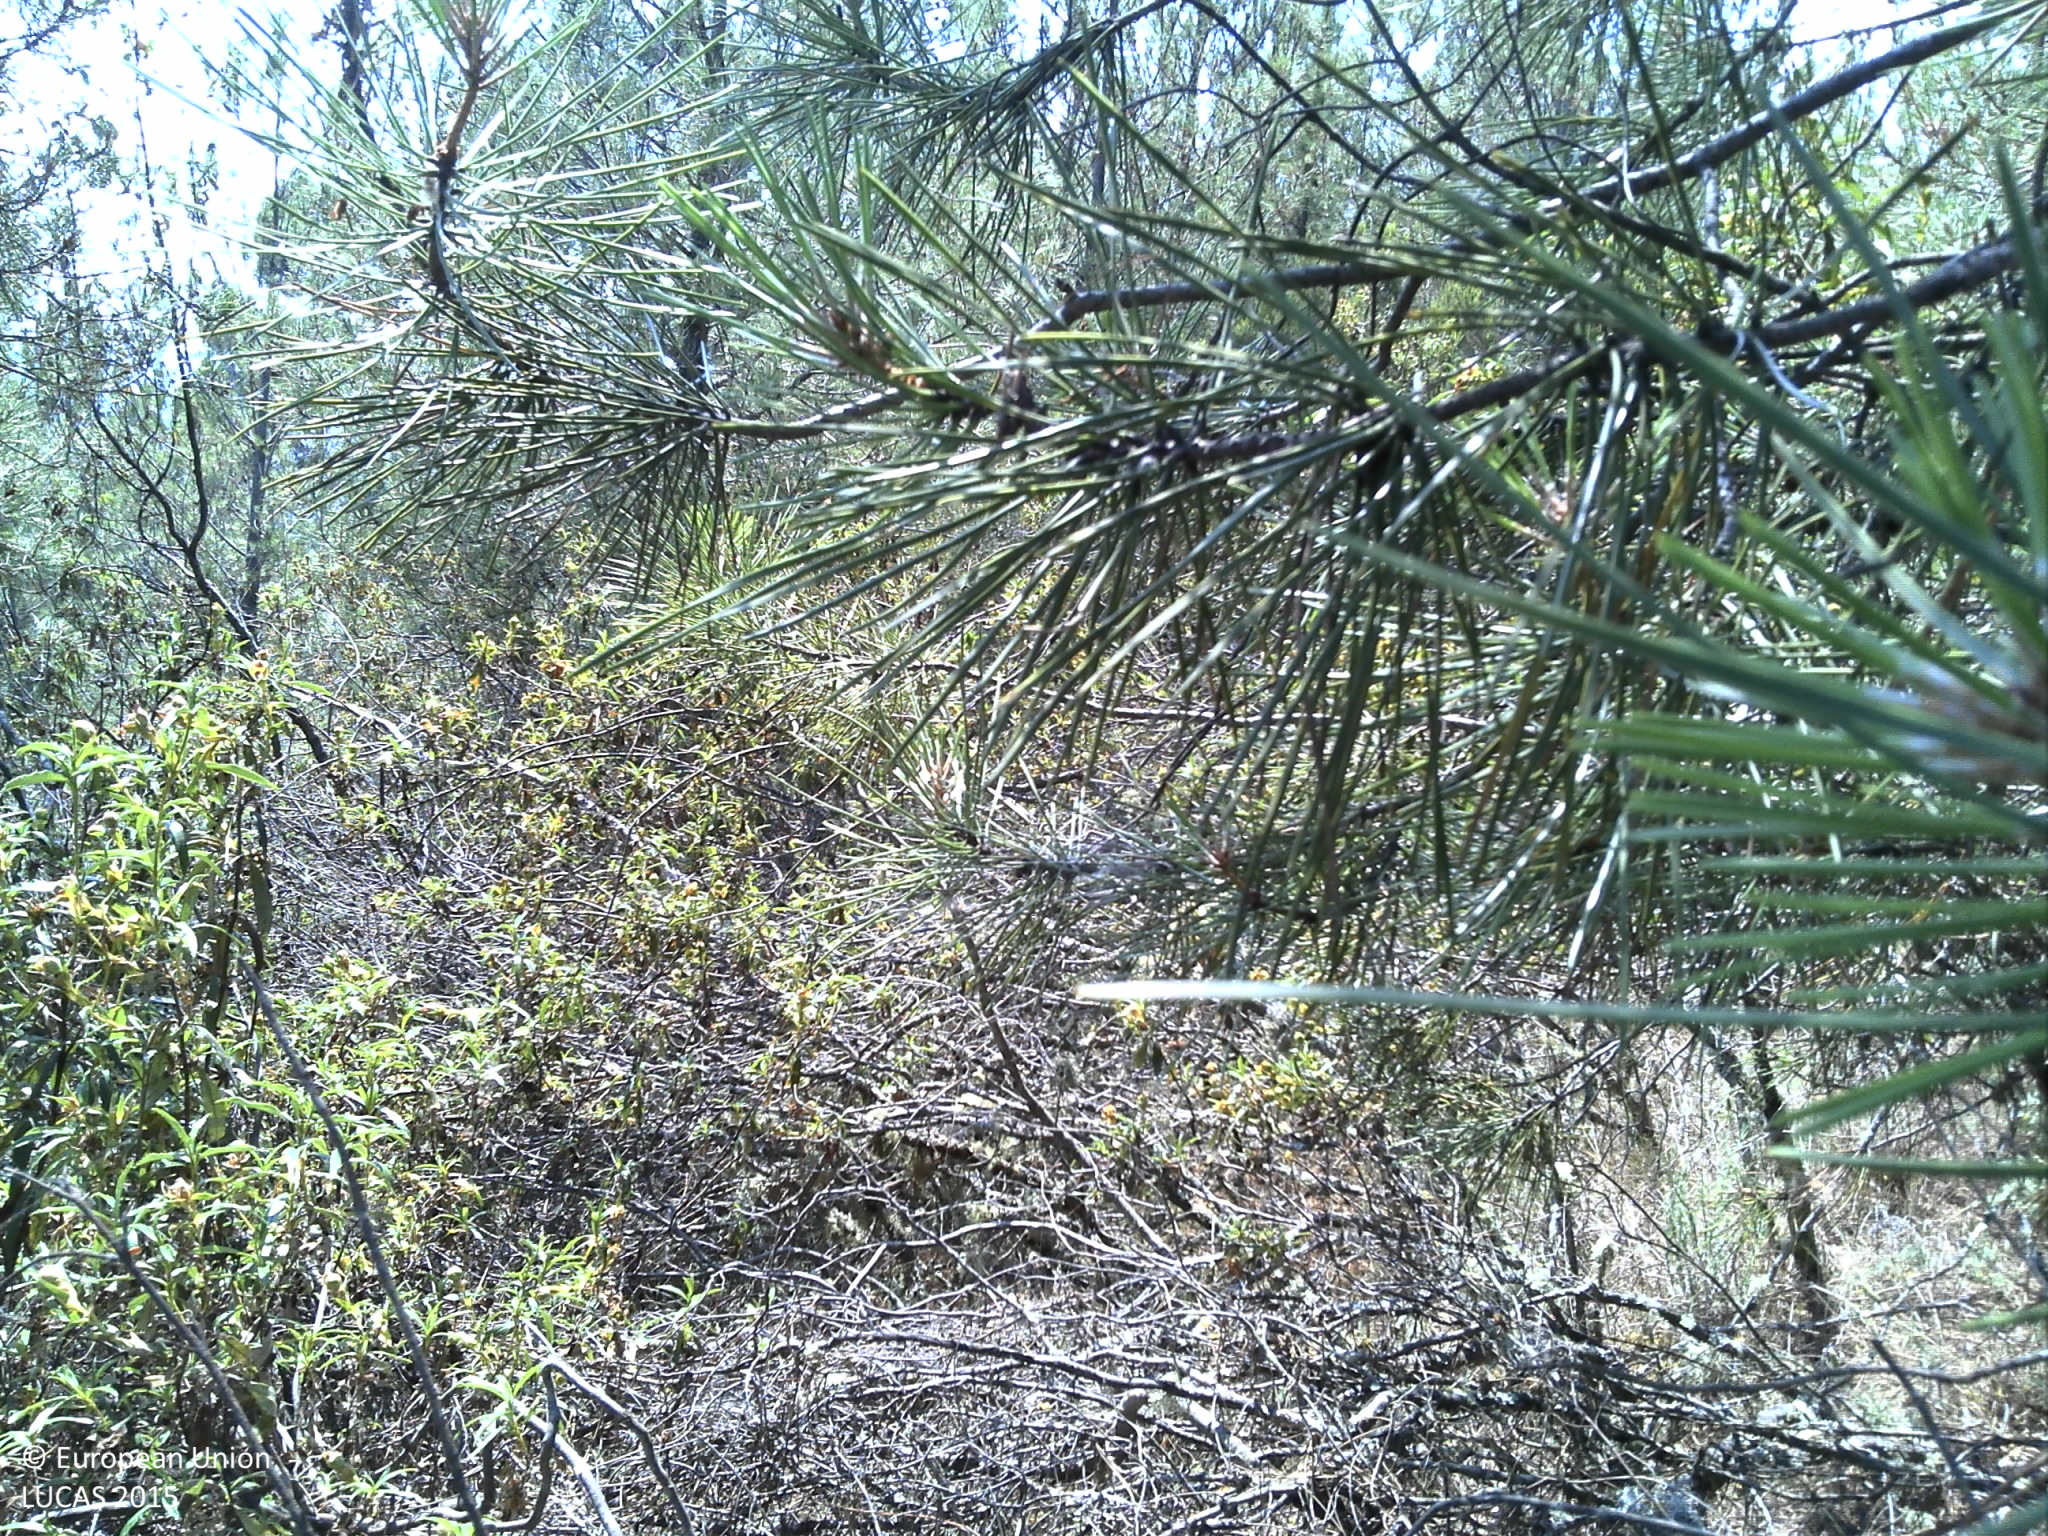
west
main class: Woodland
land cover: Pine dominated coniferous woodland
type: coniferous forest of the mediterranean region
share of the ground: 10 - 25 %
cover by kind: shrubs 80 %, coniferous forest trees 20 %
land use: Forestry
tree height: > 5 m
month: June
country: PT
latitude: 41.1879
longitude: -7.6155
